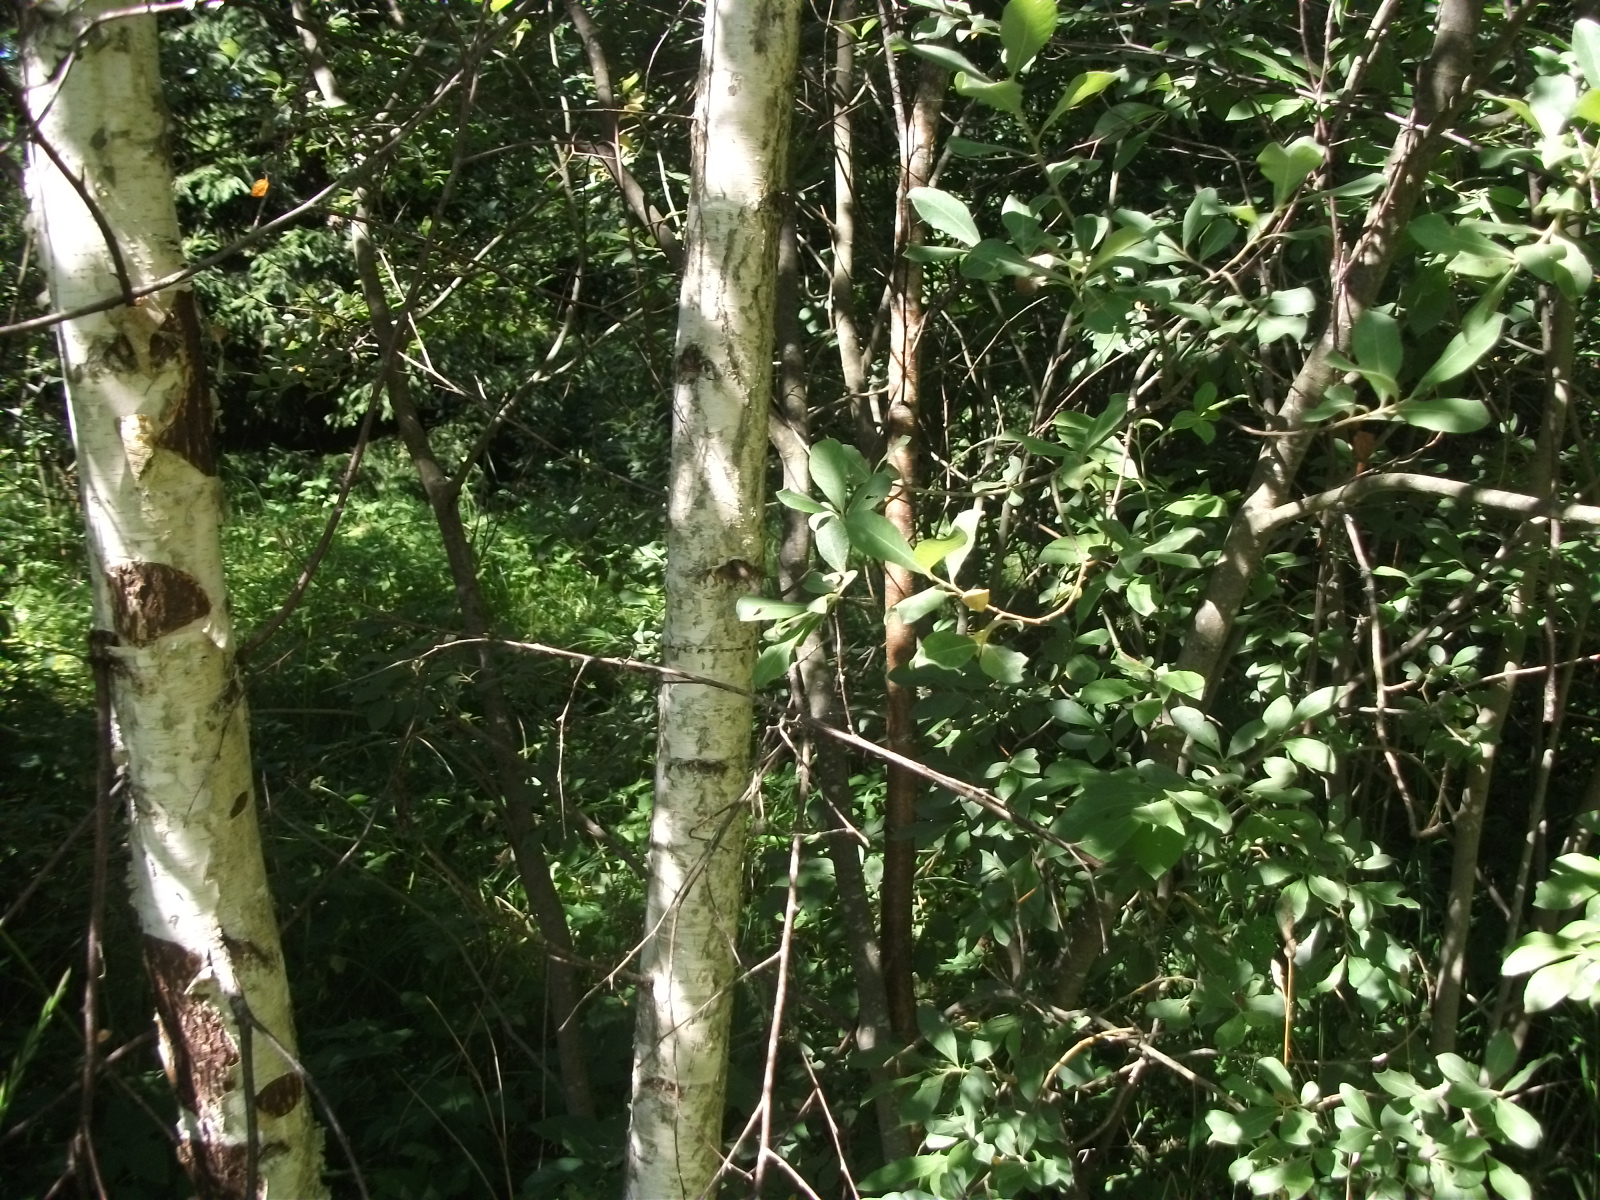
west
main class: Woodland
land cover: Broadleaved woodland
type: non-riverine alder, birch or aspen forest
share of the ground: > 75 %
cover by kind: broadleaved forest trees 75 %, shrubs 15 %, herbaceous plants 10 %
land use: Forestry
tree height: > 5 m
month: August
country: LV
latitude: 57.0050
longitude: 26.4948
